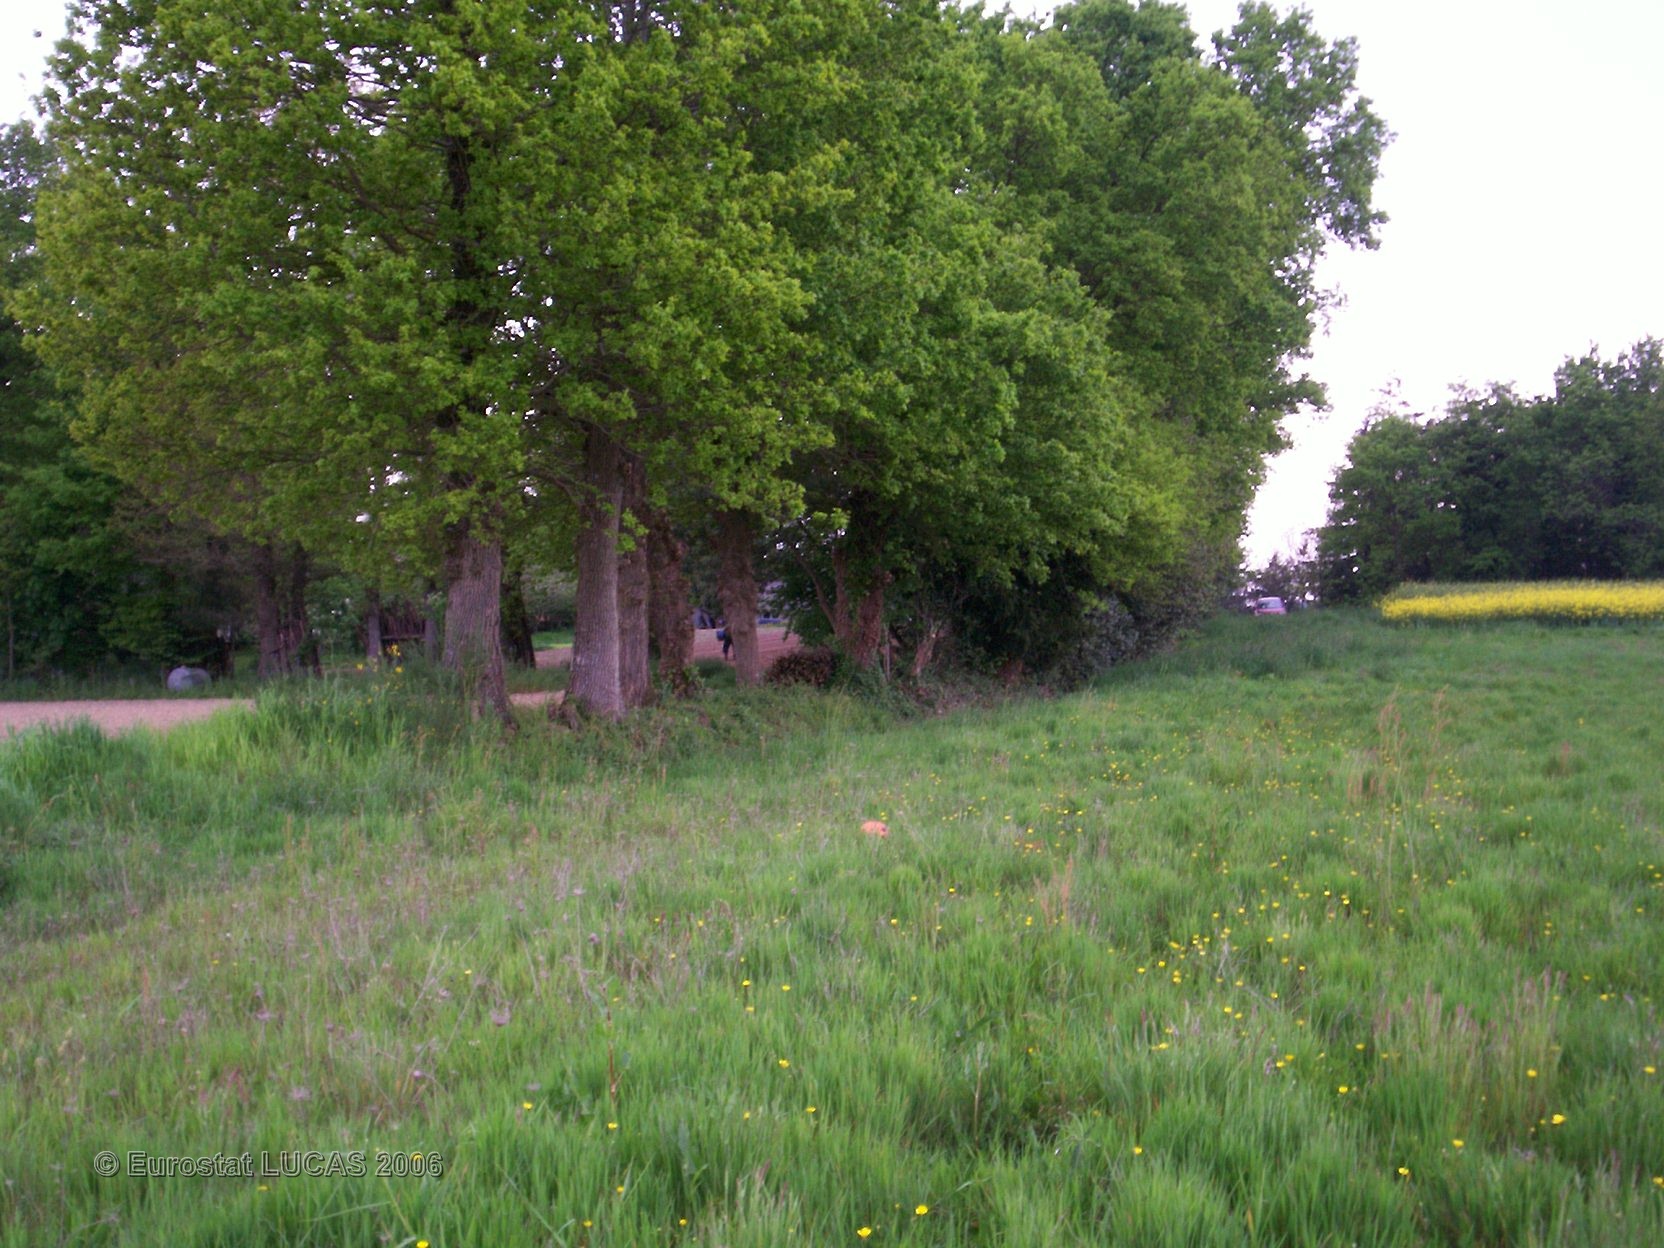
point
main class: Grassland
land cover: Grassland without tree/shrub cover
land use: Agriculture (excluding fallow land and kitchen gardens)
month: May
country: FR
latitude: 47.8107
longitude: -2.2469
